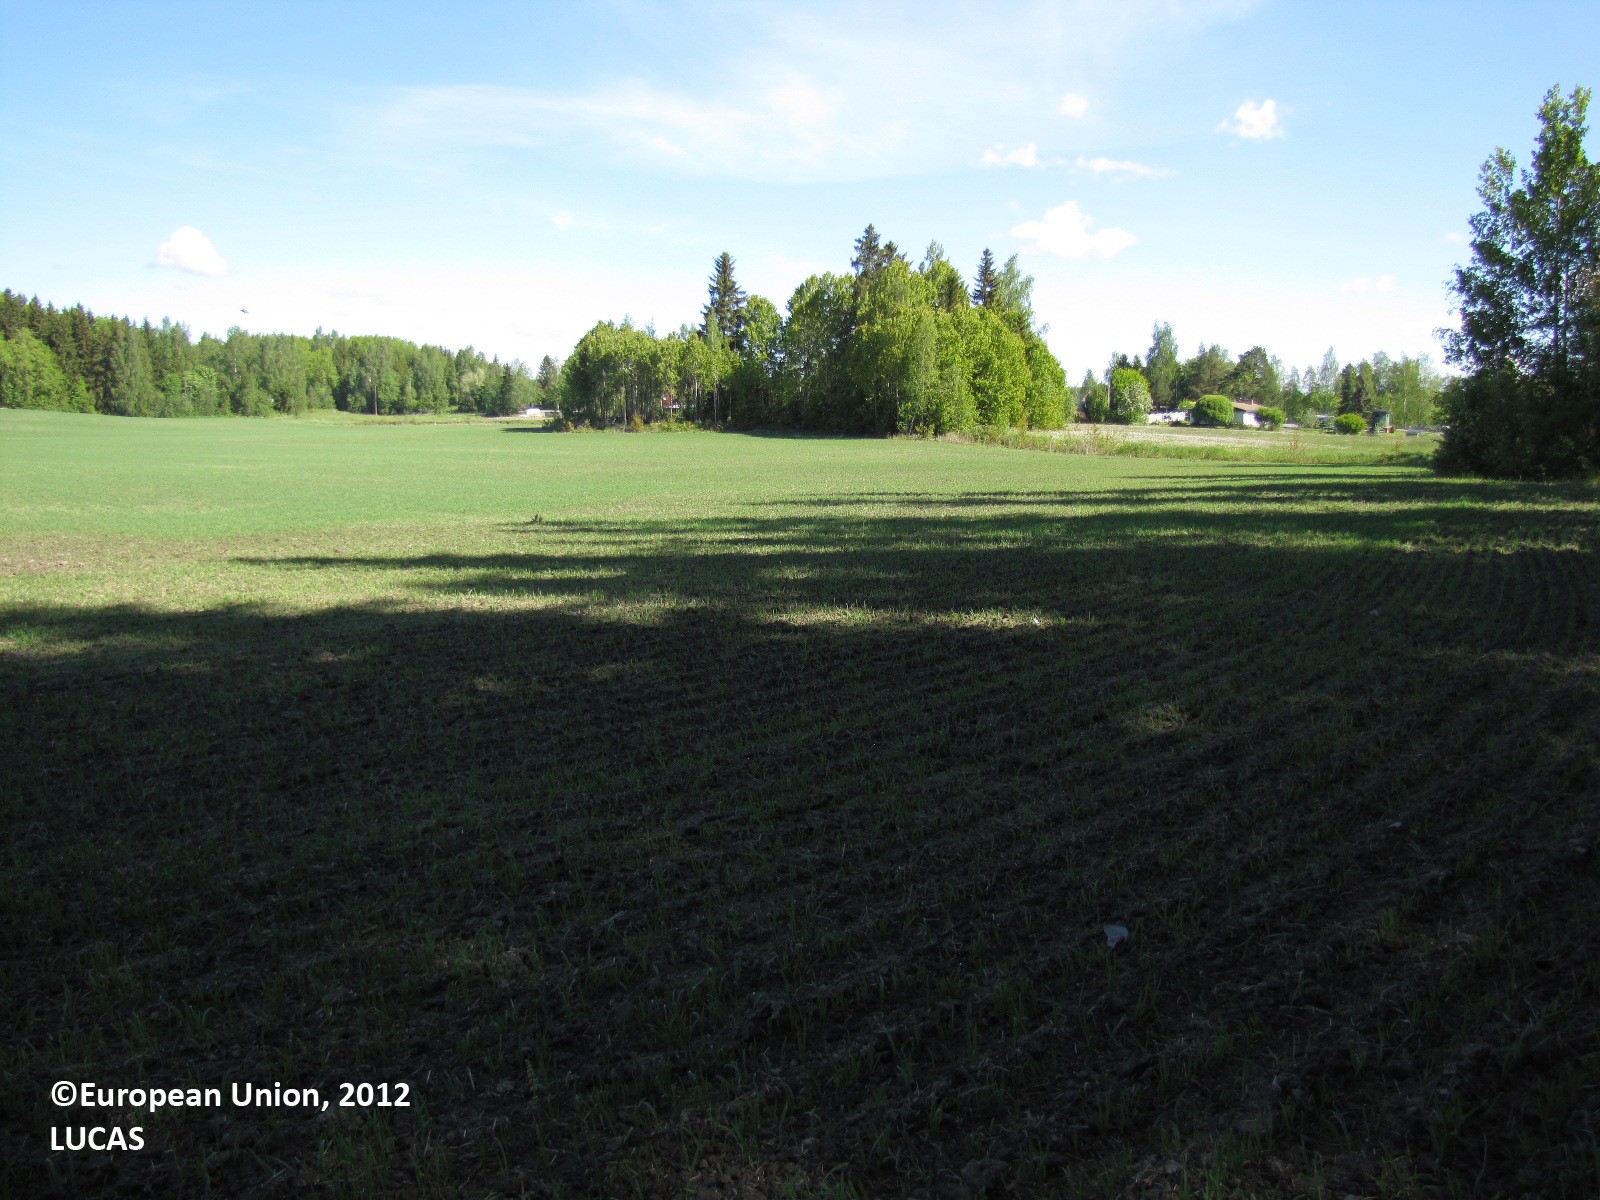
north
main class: Cropland
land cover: Oats
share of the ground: < 10 %
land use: Agriculture (excluding fallow land and kitchen gardens)
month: June
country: FI
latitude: 61.3298
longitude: 23.0212
